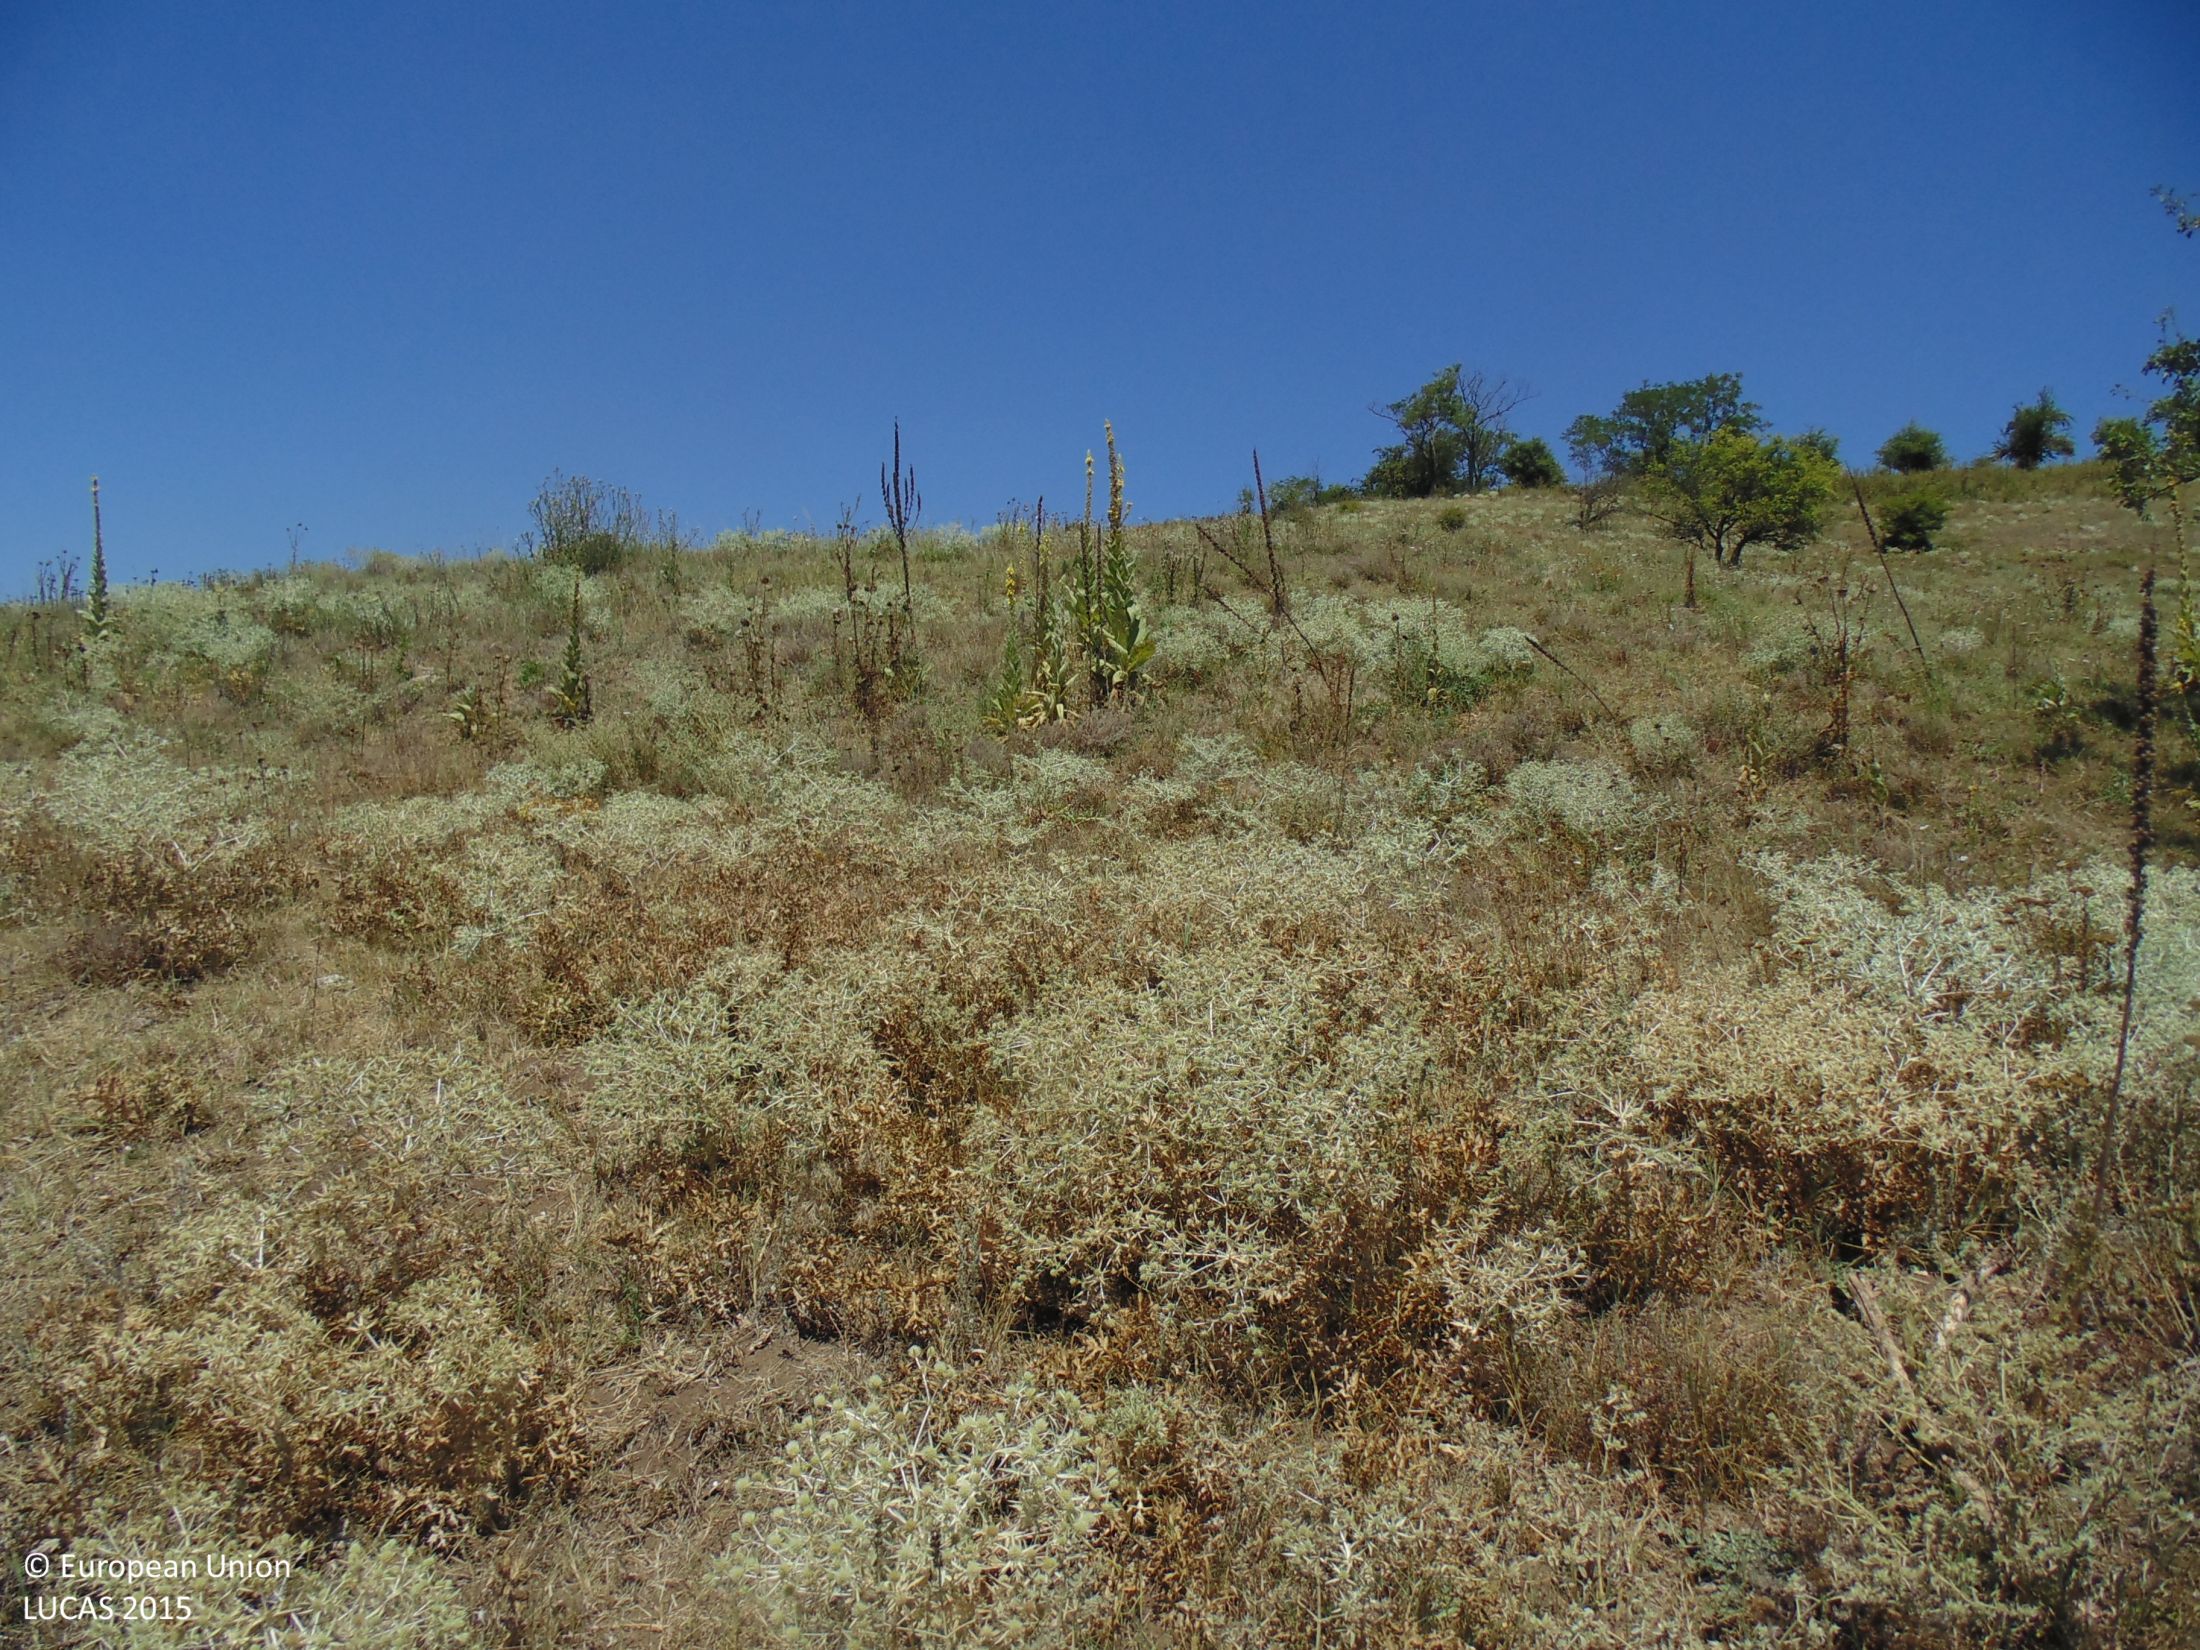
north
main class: Grassland
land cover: Grassland with sparse tree/shrub cover
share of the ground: > 75 %
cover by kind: herbaceous plants 90 %, broadleaved forest trees 5 %, shrubs 5 %
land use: Agriculture (excluding fallow land and kitchen gardens)
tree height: < 5 m
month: July
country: BG
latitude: 43.6908
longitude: 27.7455
